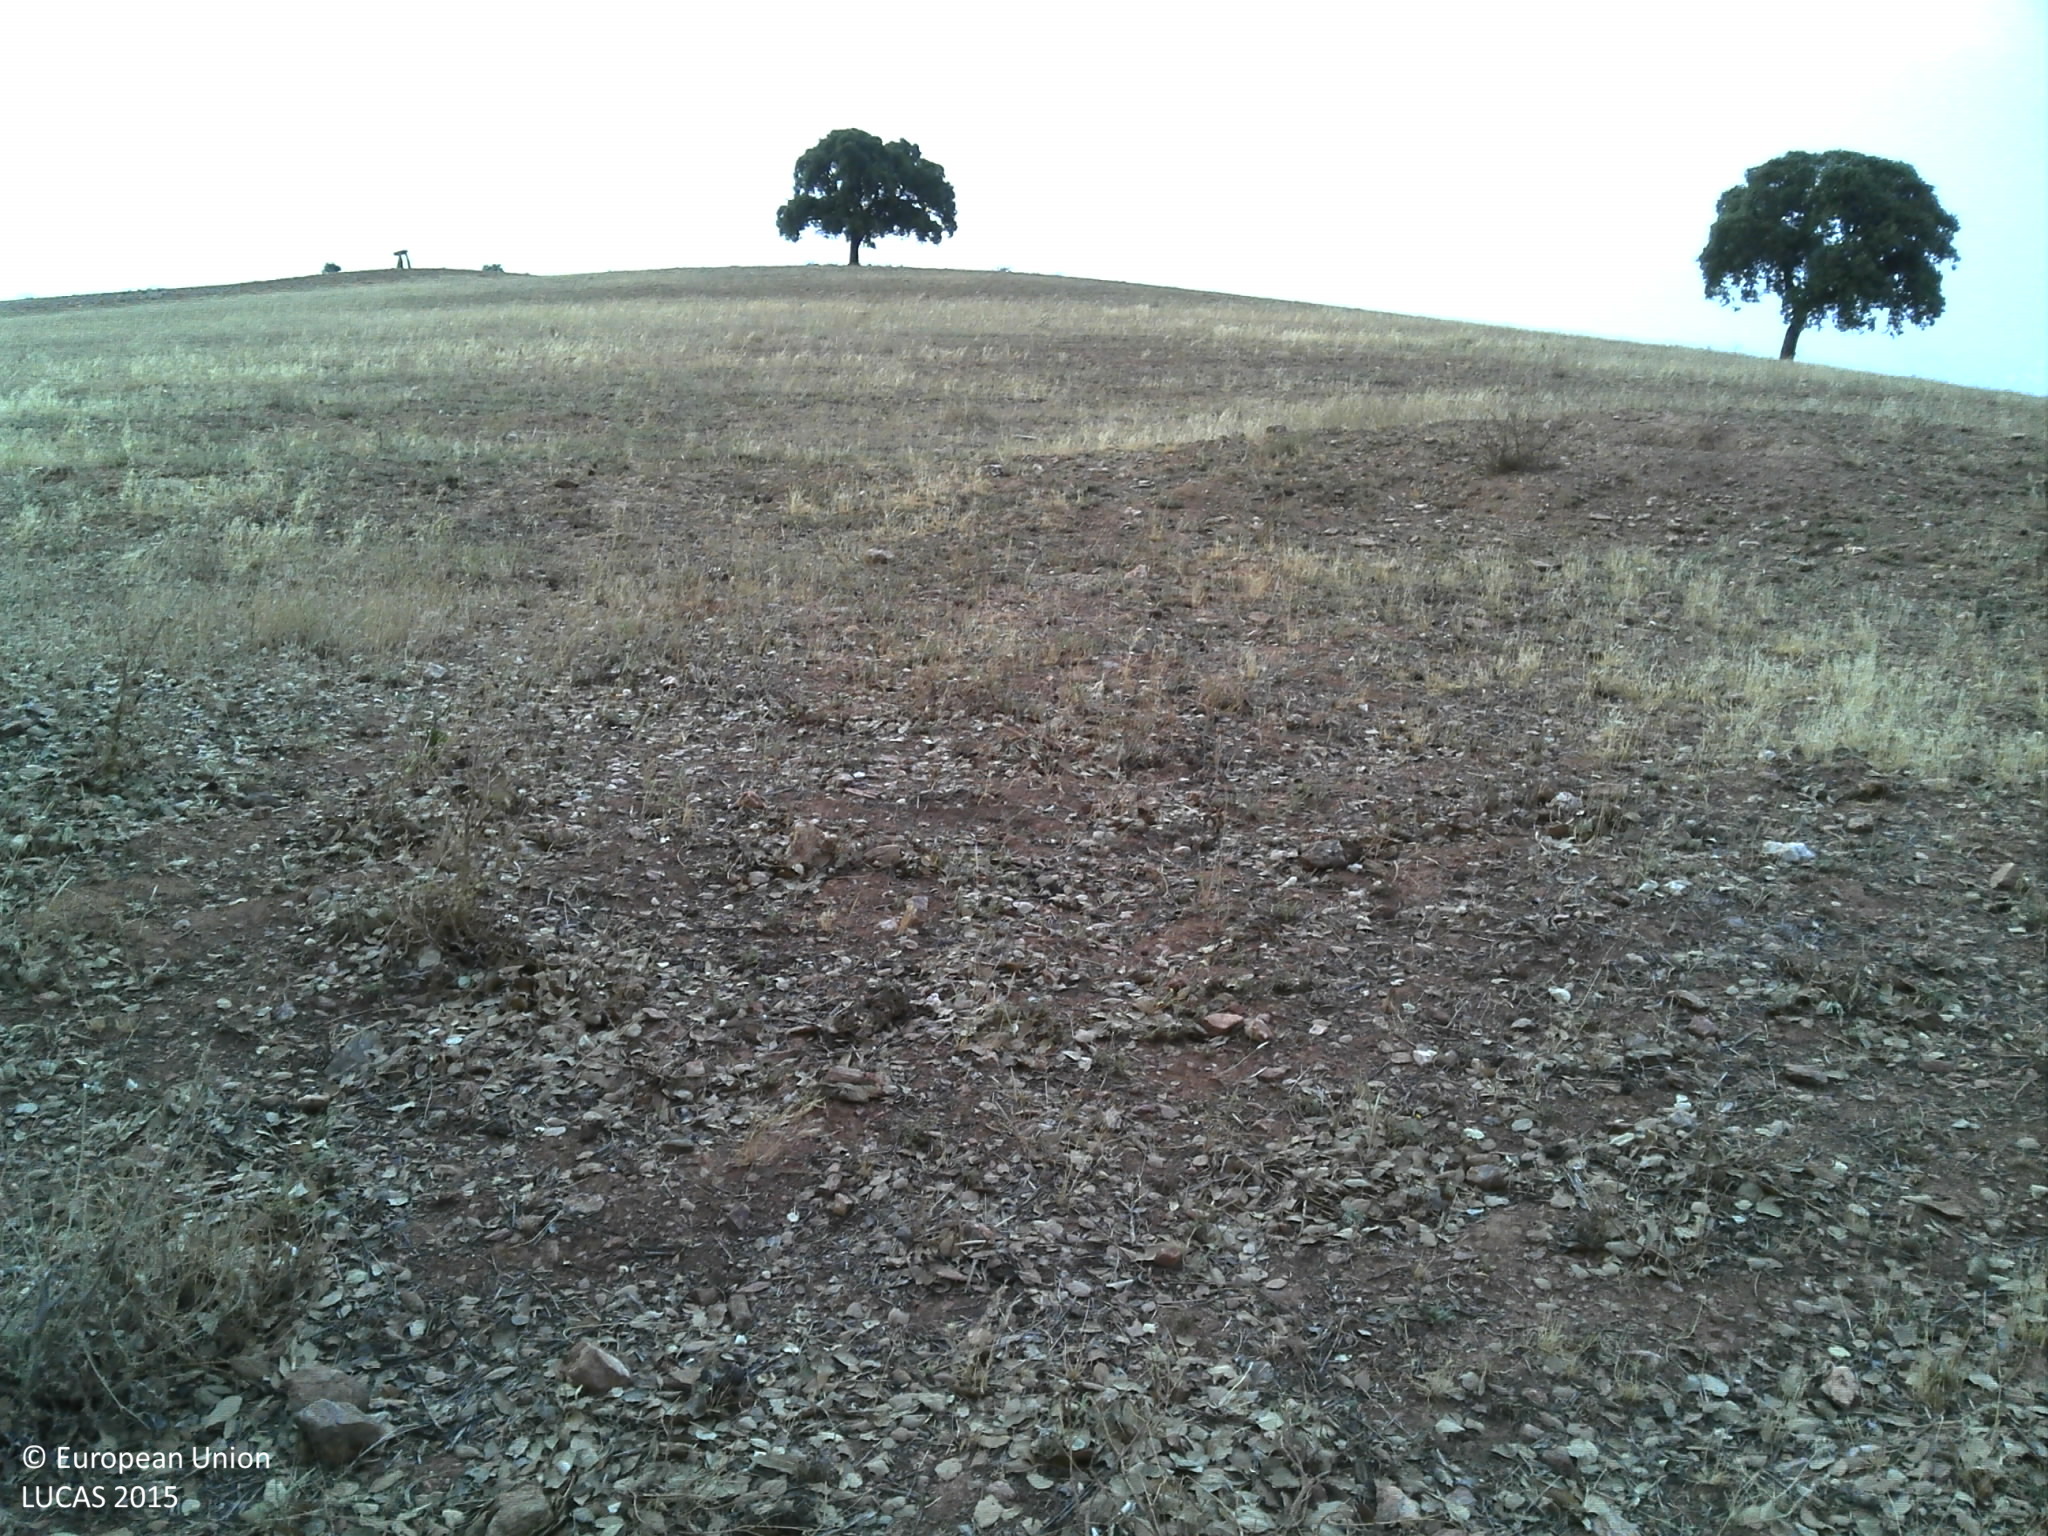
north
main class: Grassland
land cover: Grassland with sparse tree/shrub cover
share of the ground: 10 - 25 %
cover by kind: unconsolidated bare surface 80 %, herbaceous plants 15 %, broadleaved forest trees 5 %
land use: Agriculture (excluding fallow land and kitchen gardens)
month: June
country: PT
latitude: 37.8533
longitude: -7.5774
